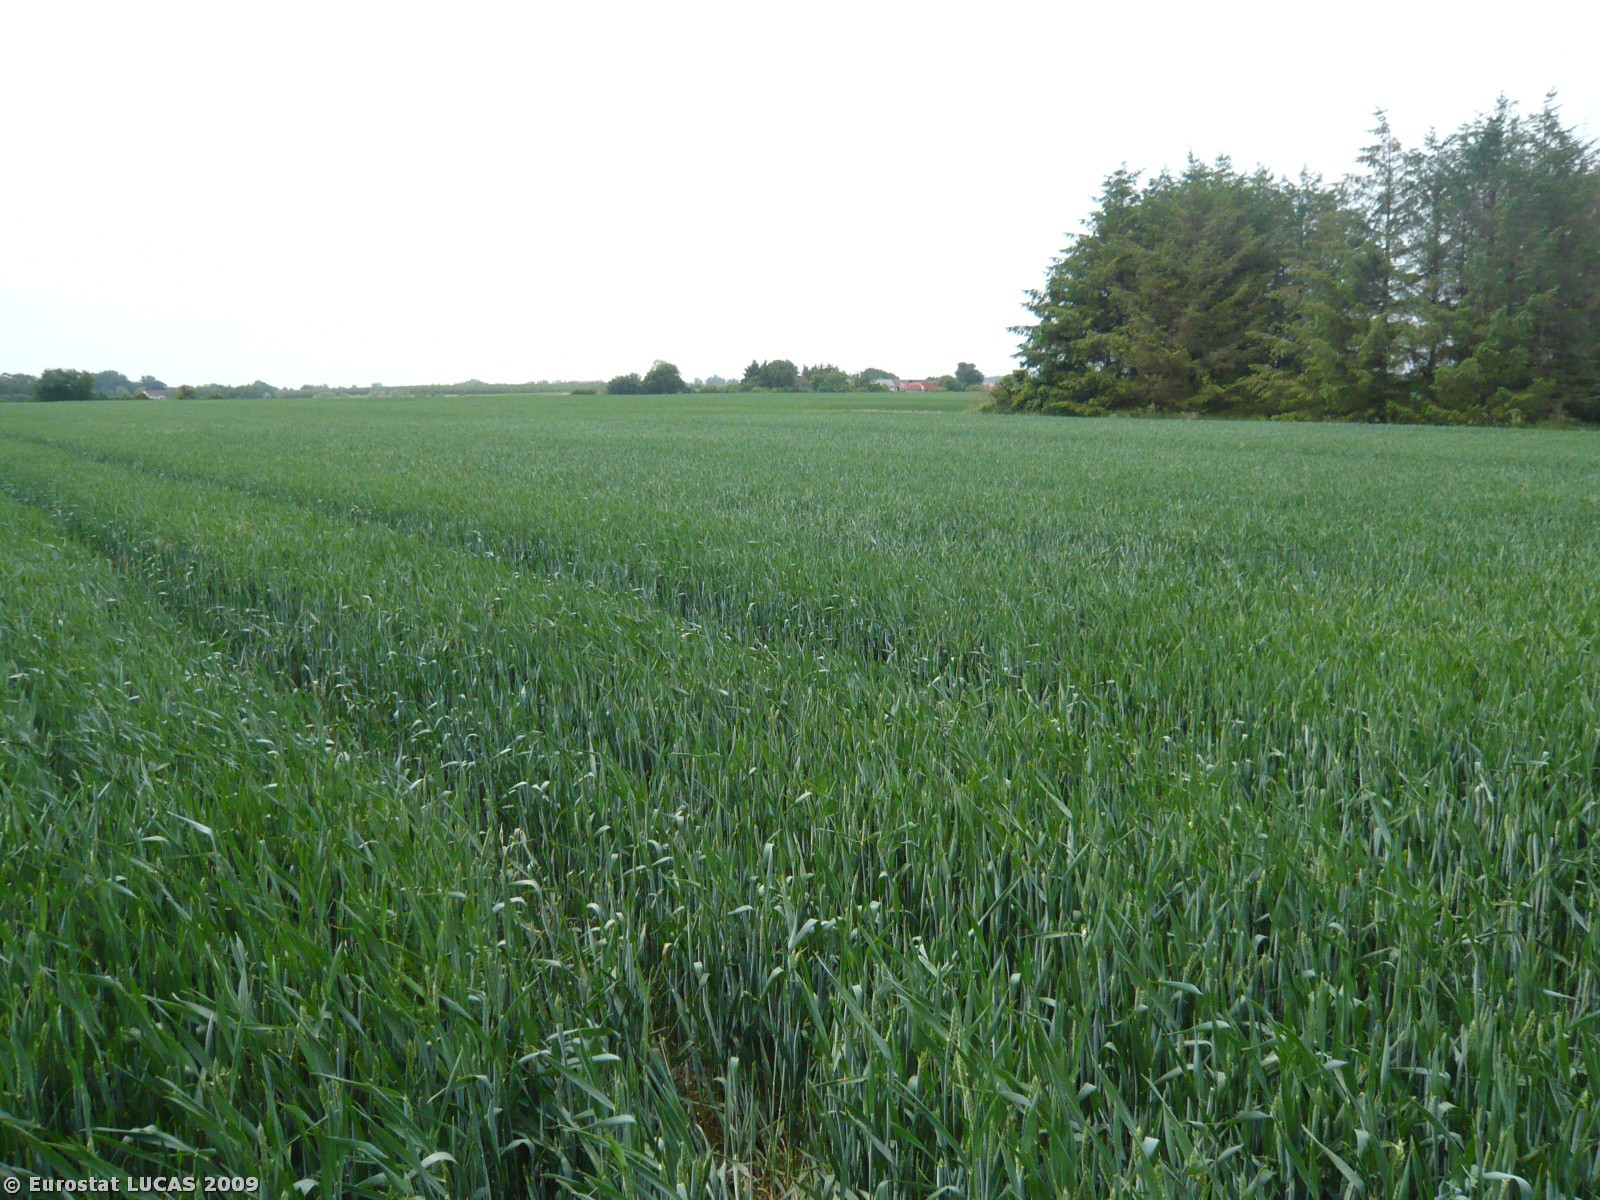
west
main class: Cropland
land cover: Common wheat
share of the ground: > 75 %
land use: Agriculture (excluding fallow land and kitchen gardens)
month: June
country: DK
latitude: 55.2816
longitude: 11.3686
